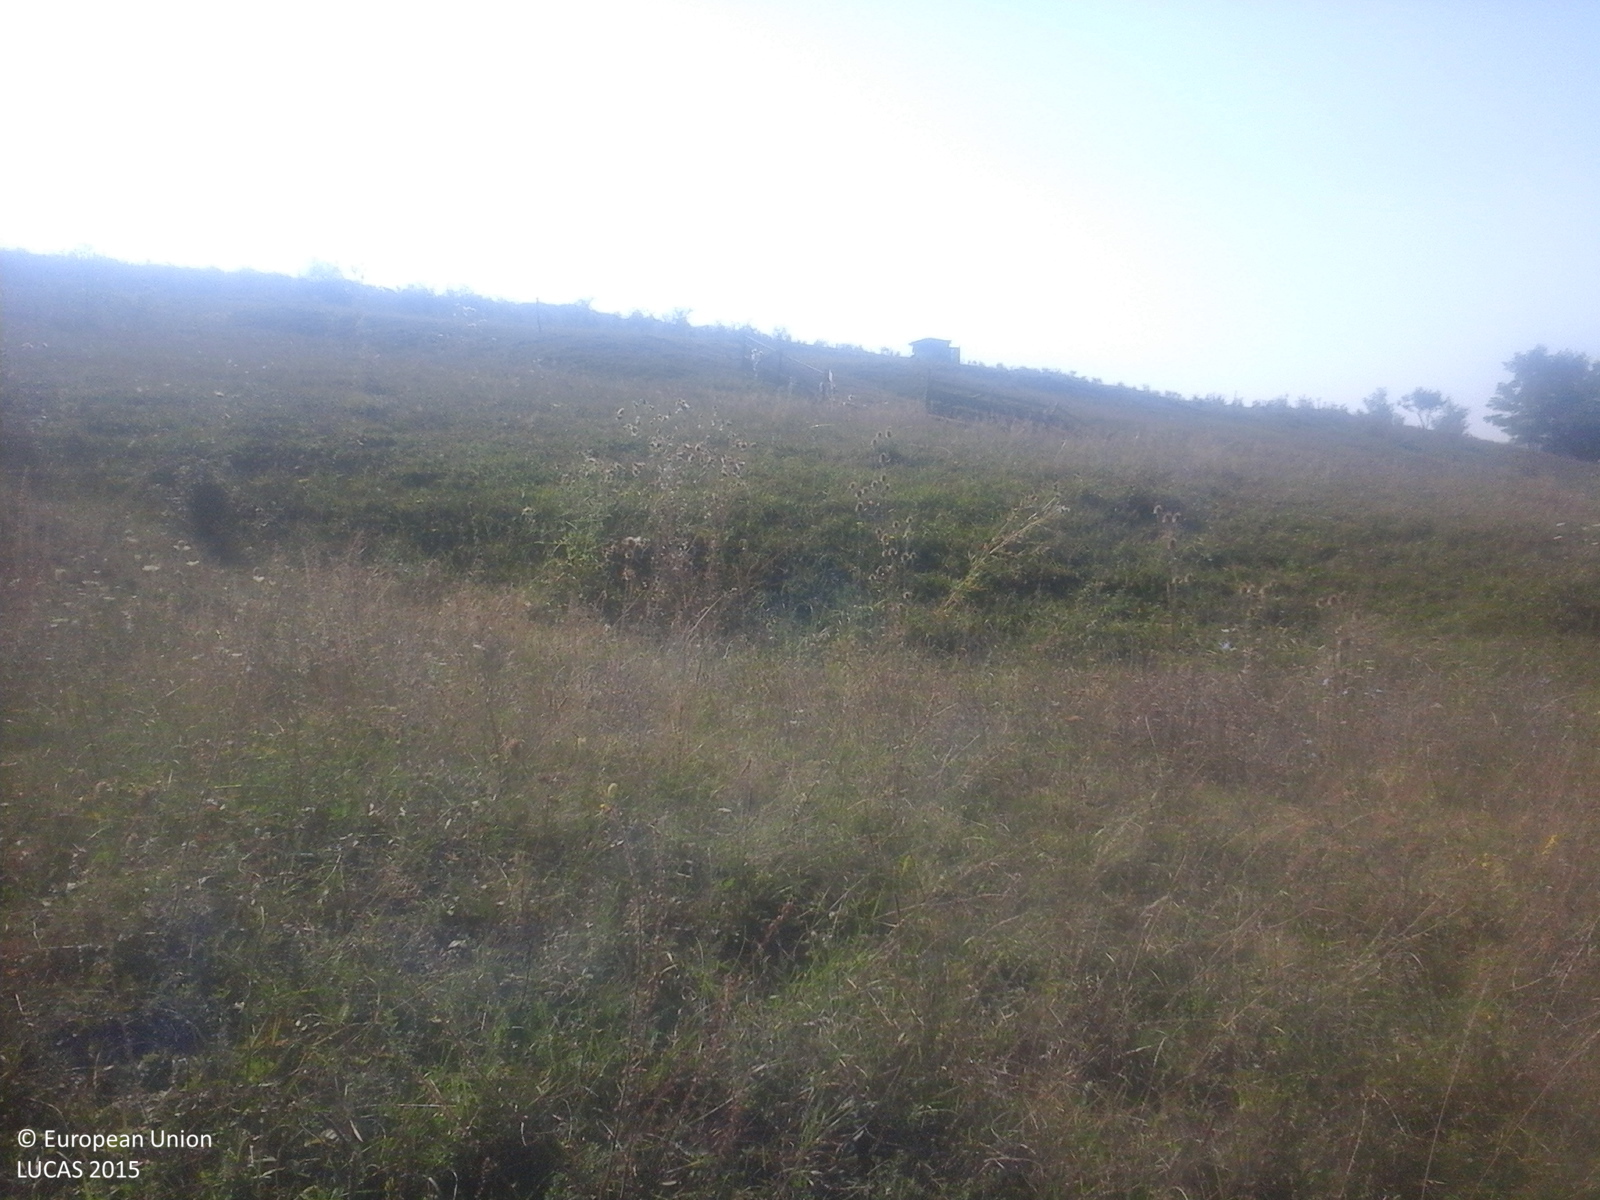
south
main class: Cropland
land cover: Maize
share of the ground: > 75 %
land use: Agriculture (excluding fallow land and kitchen gardens)
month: September
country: RO
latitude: 46.8451
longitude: 24.4472
